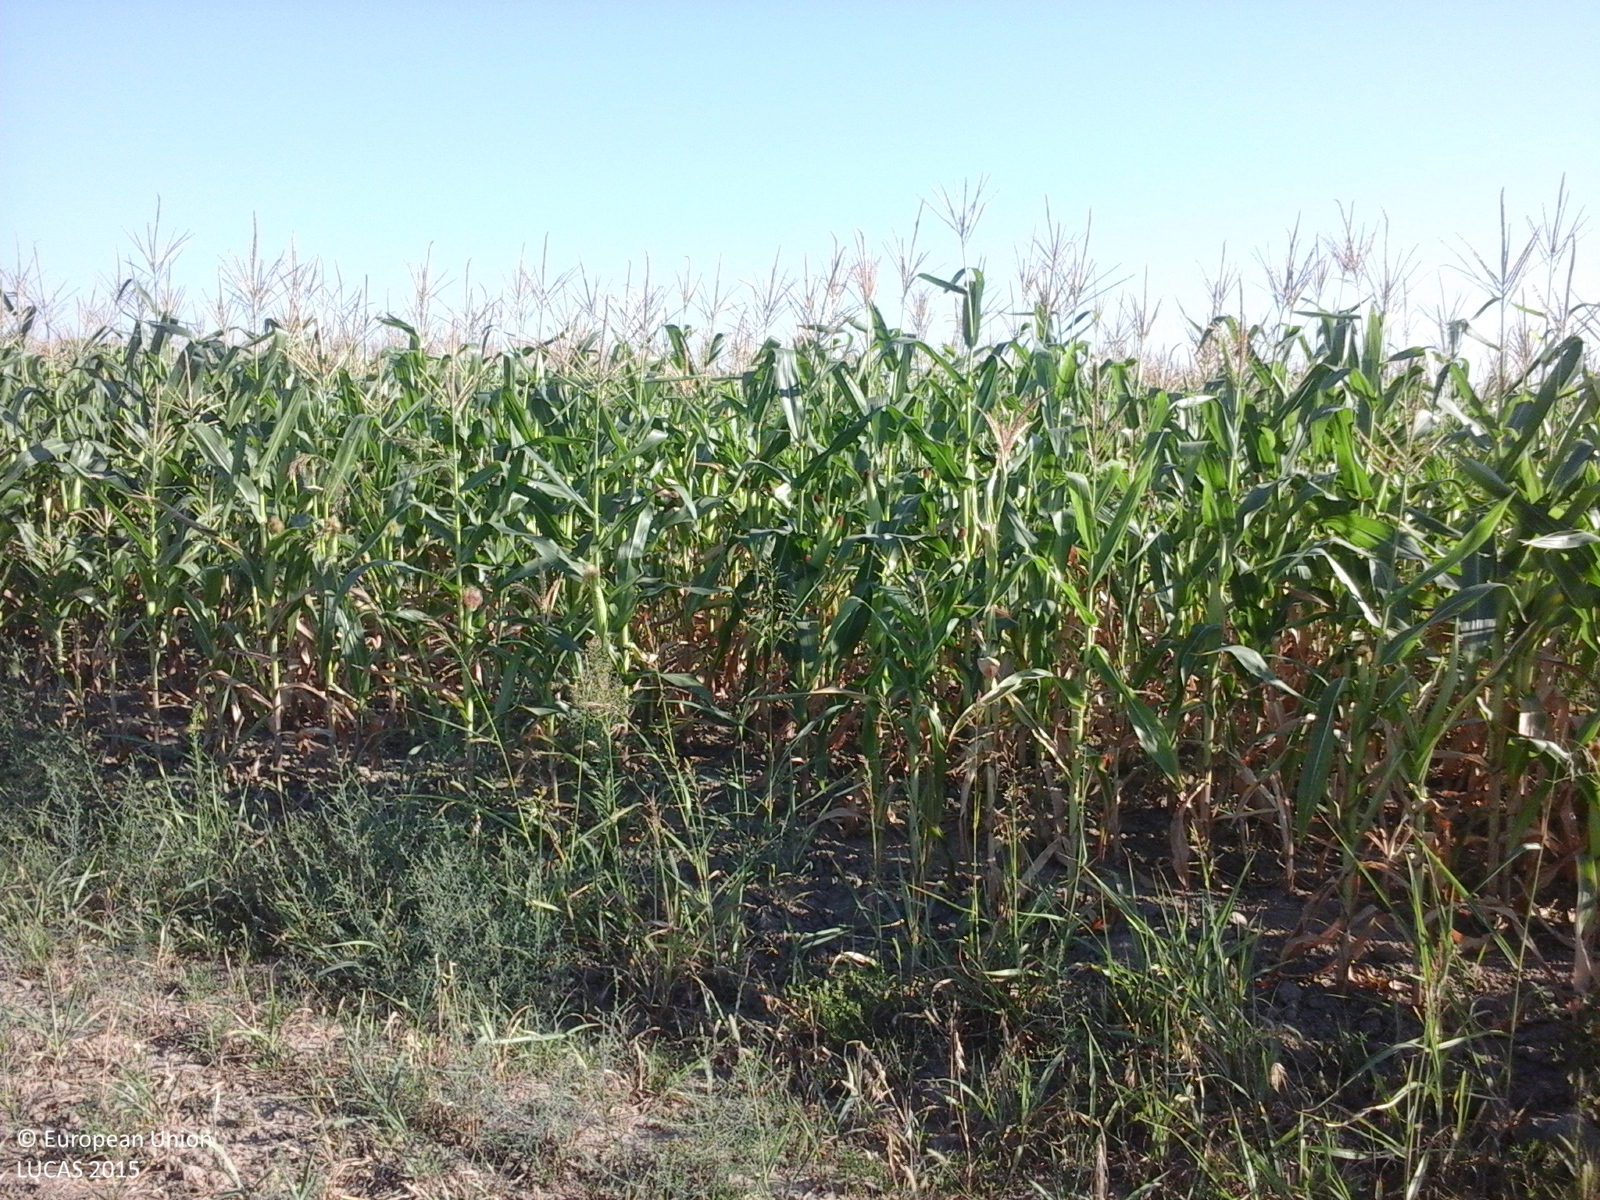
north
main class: Cropland
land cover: Maize
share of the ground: > 75 %
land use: Agriculture (excluding fallow land and kitchen gardens)
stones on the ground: < 10 %
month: August
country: RO
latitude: 44.6246
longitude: 28.0976
